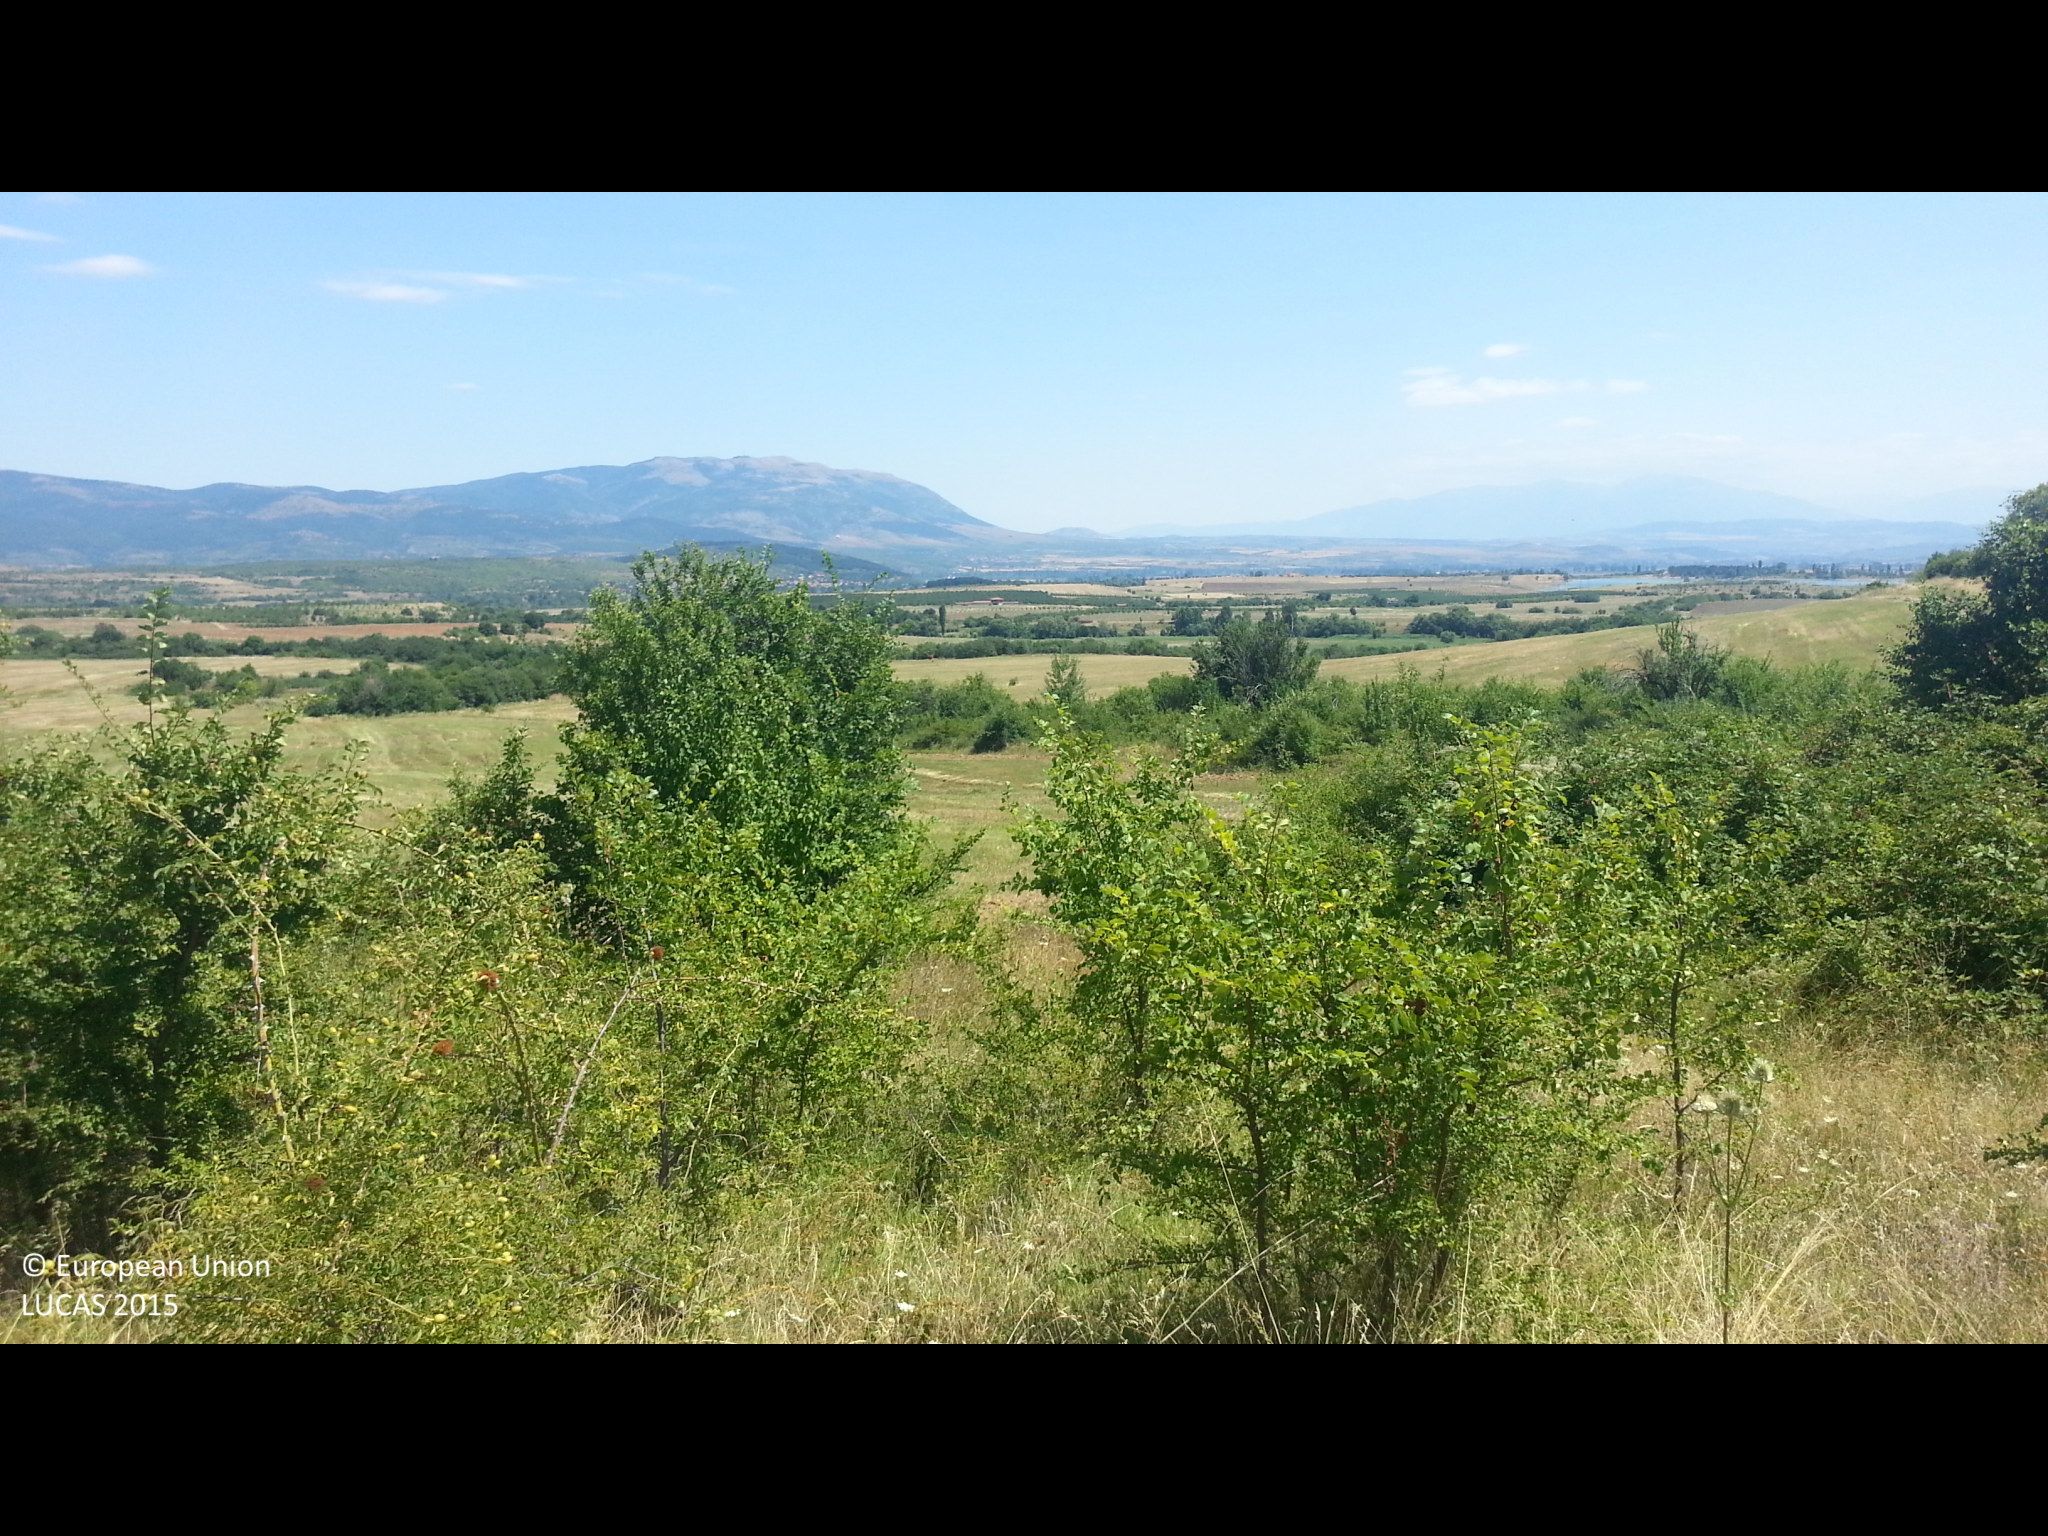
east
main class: Grassland
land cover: Grassland with sparse tree/shrub cover
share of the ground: > 75 %
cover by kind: herbaceous plants 90 %, broadleaved forest trees 5 %, shrubs 5 %
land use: Semi-natural and natural areas not in use
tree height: < 5 m
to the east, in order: Grassland with sparse tree/shrub cover; Tracks; Grassland without tree/shrub cover; Broadleaved woodland; Grassland without tree/shrub cover
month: August
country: BG
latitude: 42.3137
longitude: 22.6515
